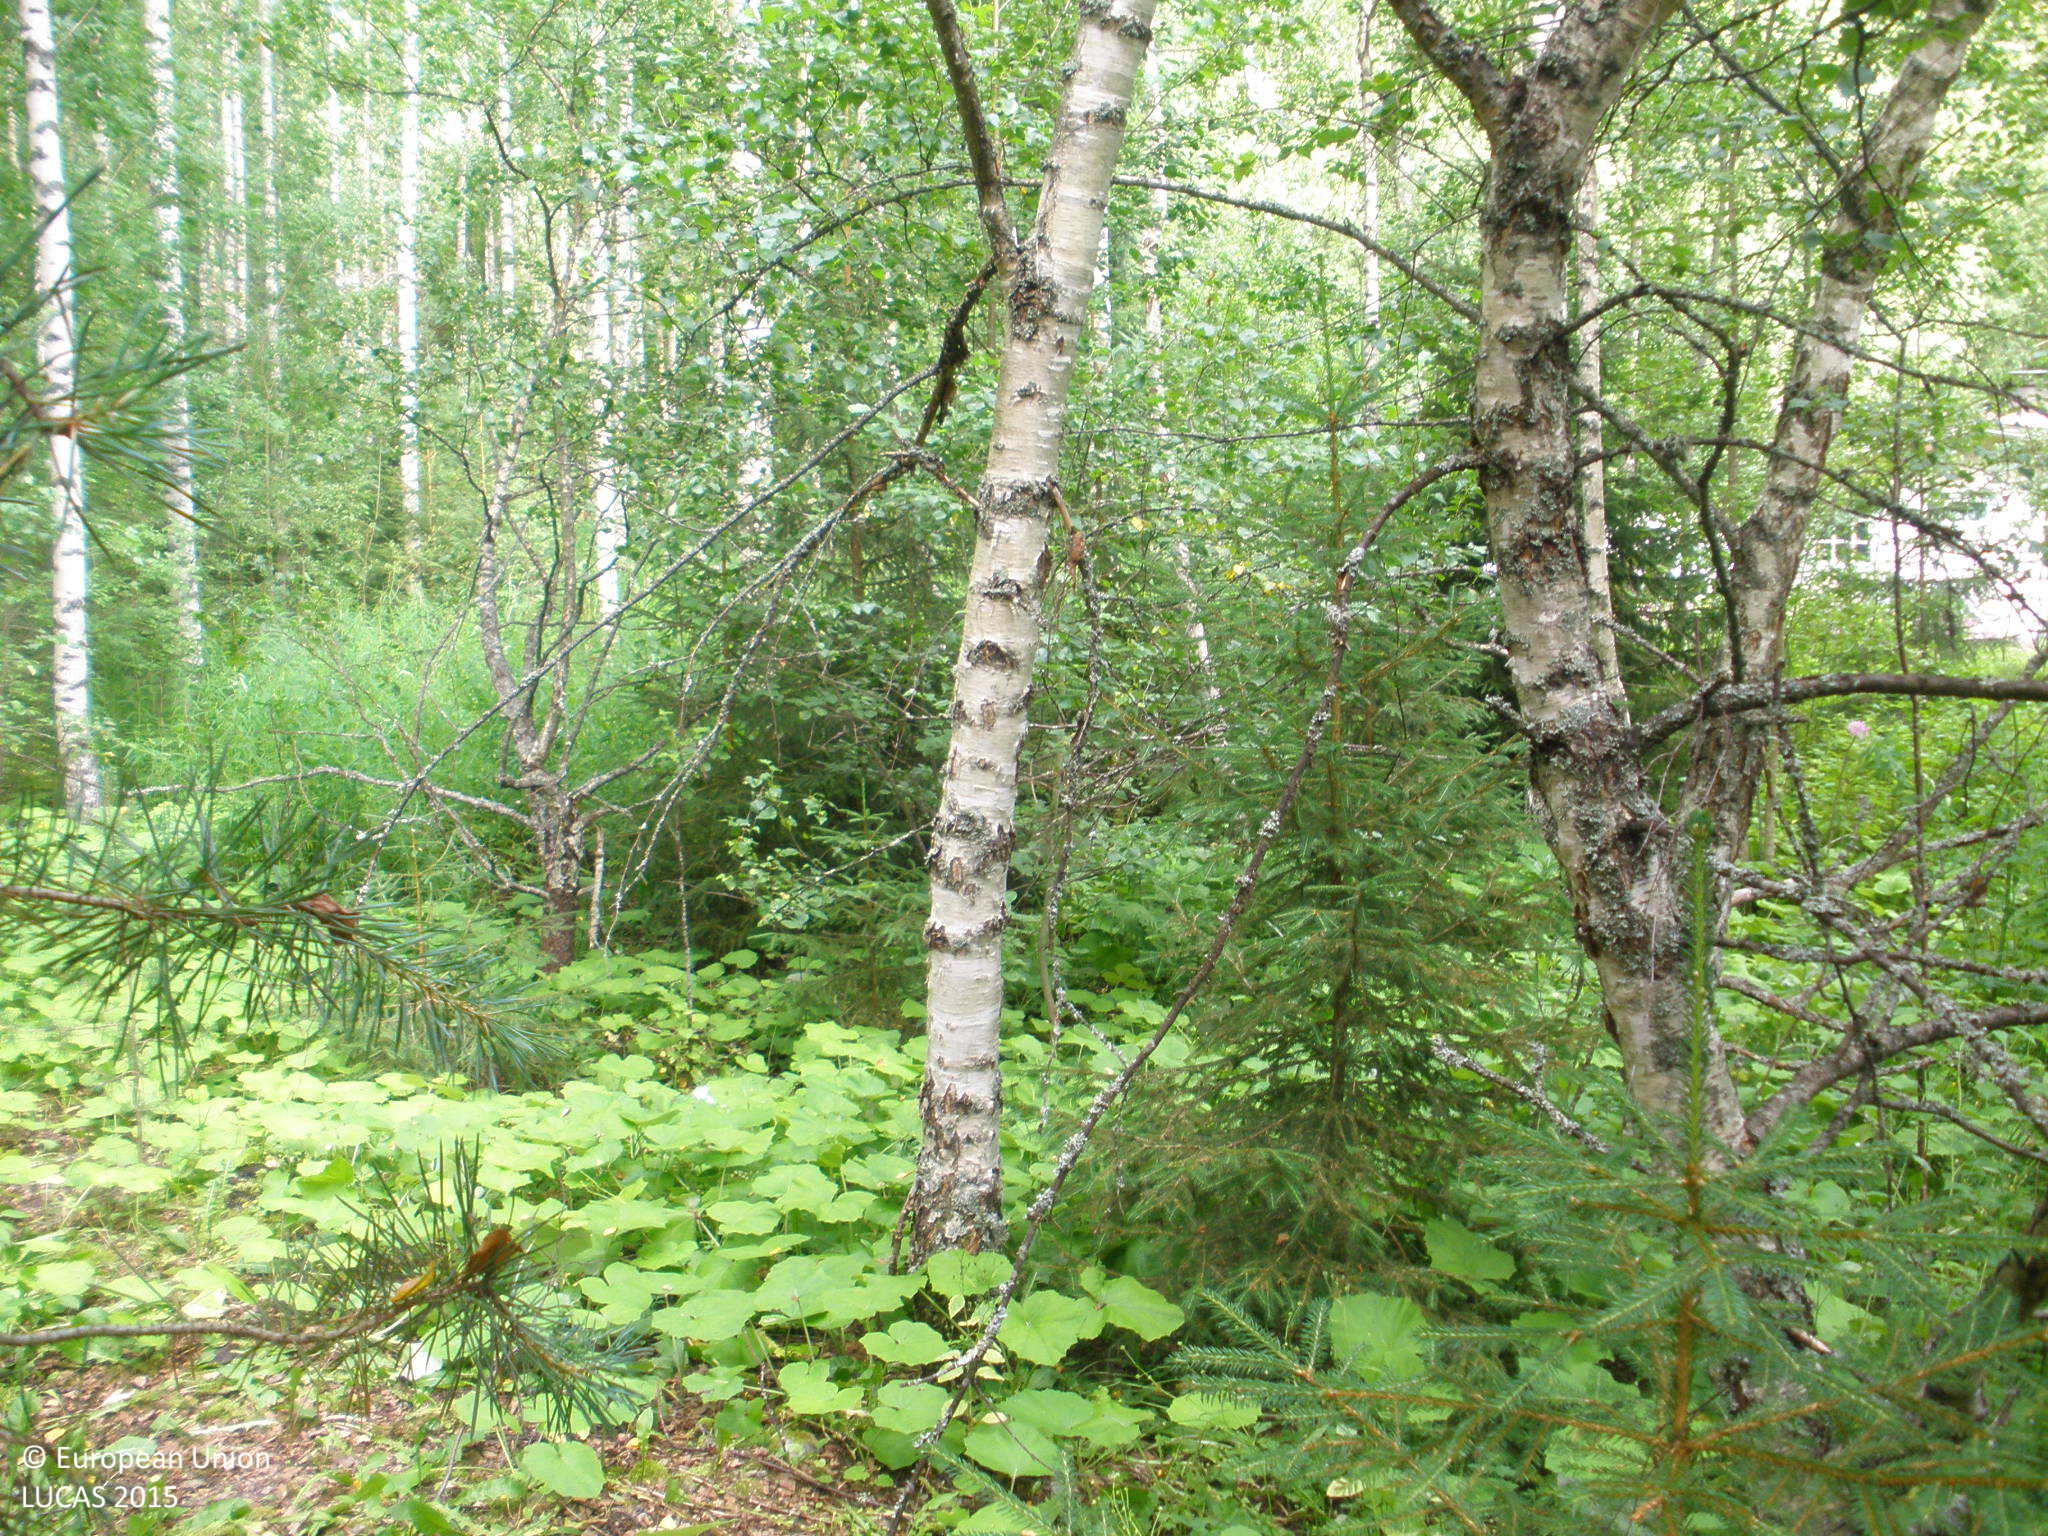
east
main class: Woodland
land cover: Spruce dominated mixed woodland
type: boreal forest
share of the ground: > 75 %
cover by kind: broadleaved forest trees 50 %, coniferous forest trees 25 %, herbaceous plants 20 %, shrubs 5 %
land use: Forestry
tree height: > 5 m
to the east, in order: Spruce dominated mixed woodland; Broadleaved woodland; Electric lines; Broadleaved woodland; Spruce dominated mixed woodland; Pine dominated coniferous woodland; Spruce dominated coniferous woodland; Ditches and canals; Electric lines; Grass margins; Paved roads, cycling and walking lanes; Grass margins; Ditches and canals; Pine dominated mixed woodland; Spruce dominated coniferous woodland
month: July
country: FI
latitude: 60.9520
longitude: 24.1083
